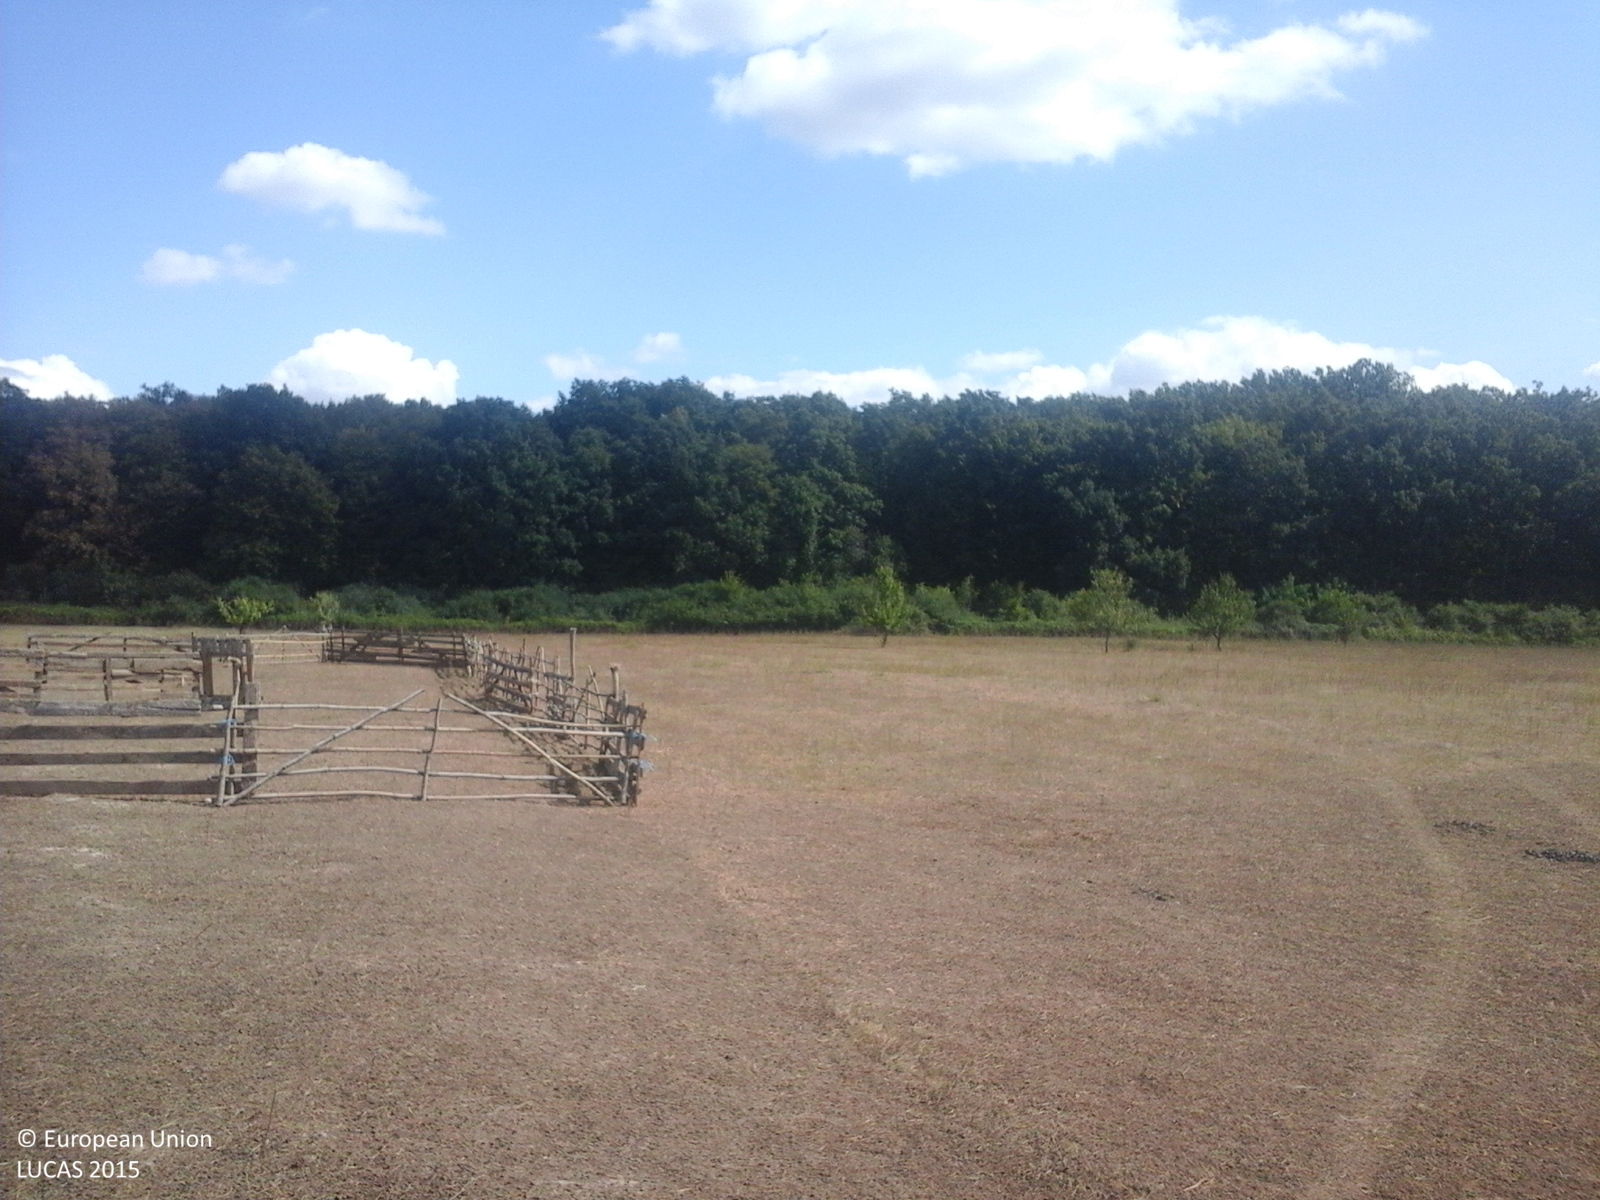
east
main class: Grassland
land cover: Grassland without tree/shrub cover
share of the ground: > 75 %
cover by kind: herbaceous plants 100 %
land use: Agriculture (excluding fallow land and kitchen gardens)
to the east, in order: Grassland without tree/shrub cover; Grassland with sparse tree/shrub cover; Grassland without tree/shrub cover; Shrubland with sparse tree cover; Broadleaved woodland
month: September
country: RO
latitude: 47.8790
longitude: 22.9156
